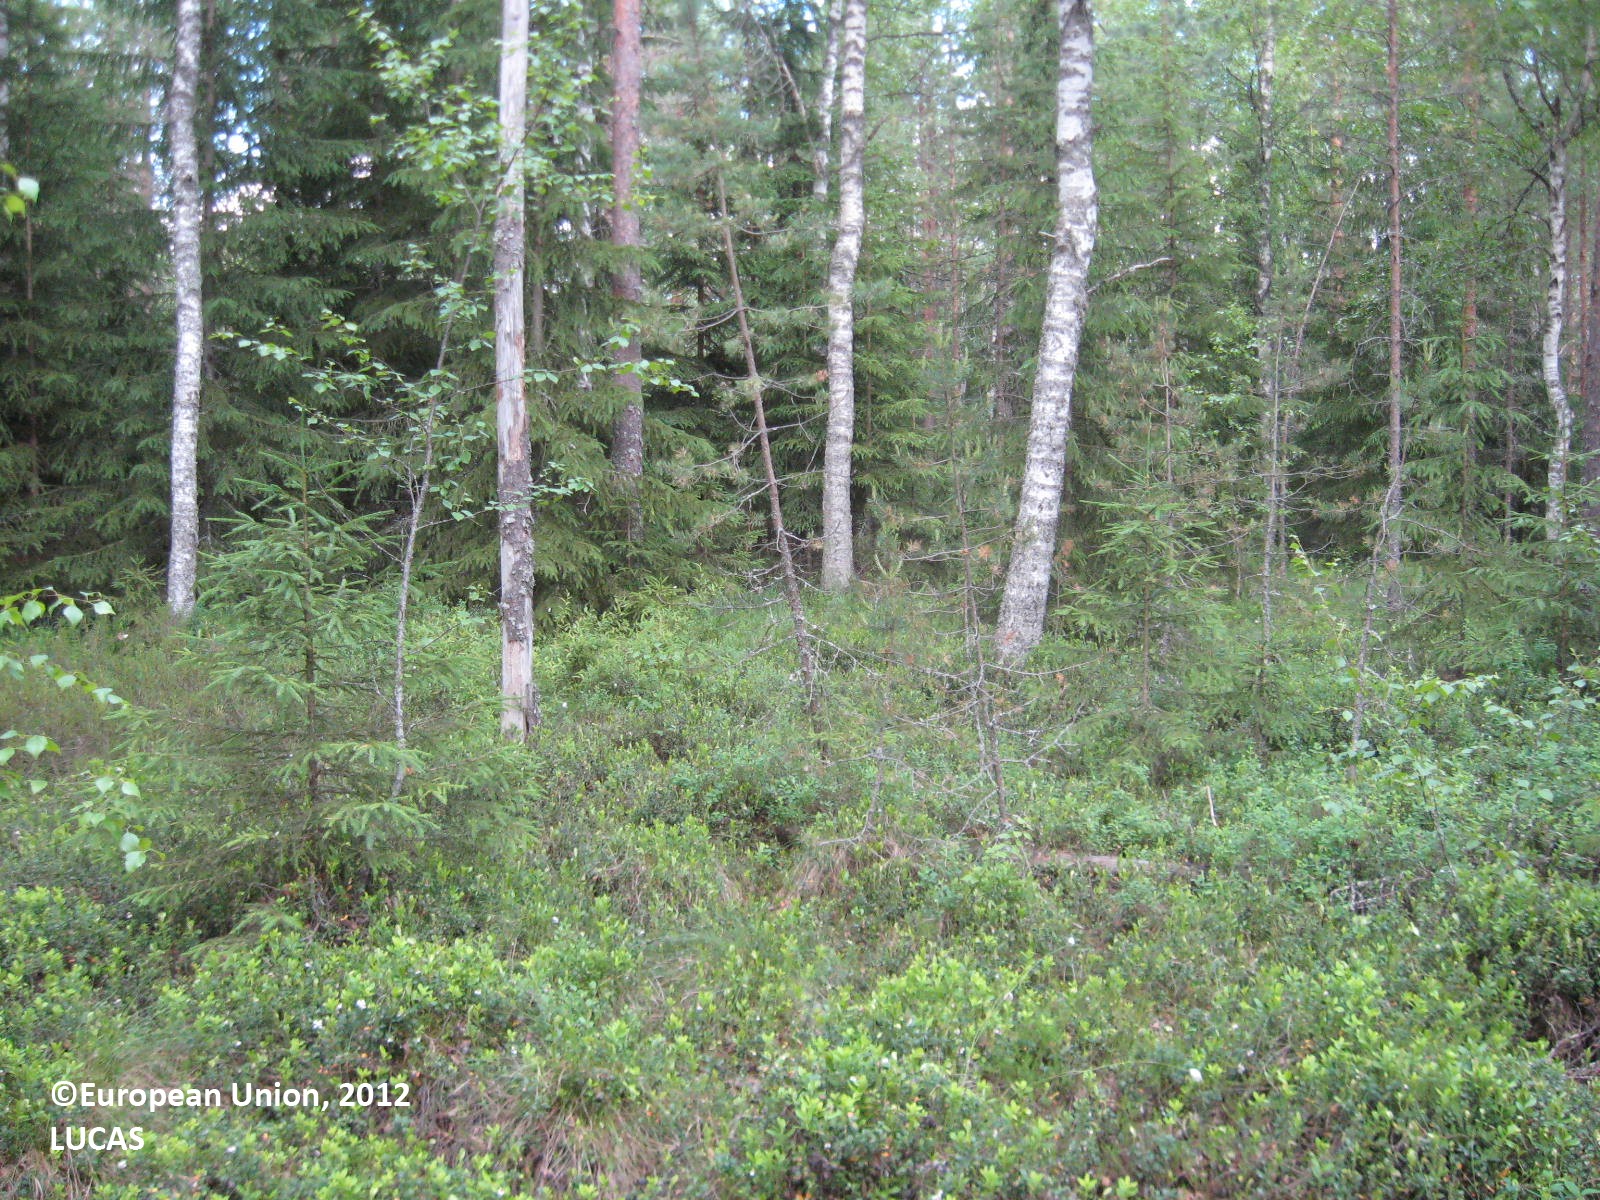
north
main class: Woodland
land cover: Other mixed woodland
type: boreal forest
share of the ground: > 75 %
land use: Forestry
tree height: > 5 m
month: July
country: FI
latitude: 62.5305
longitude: 22.4724
